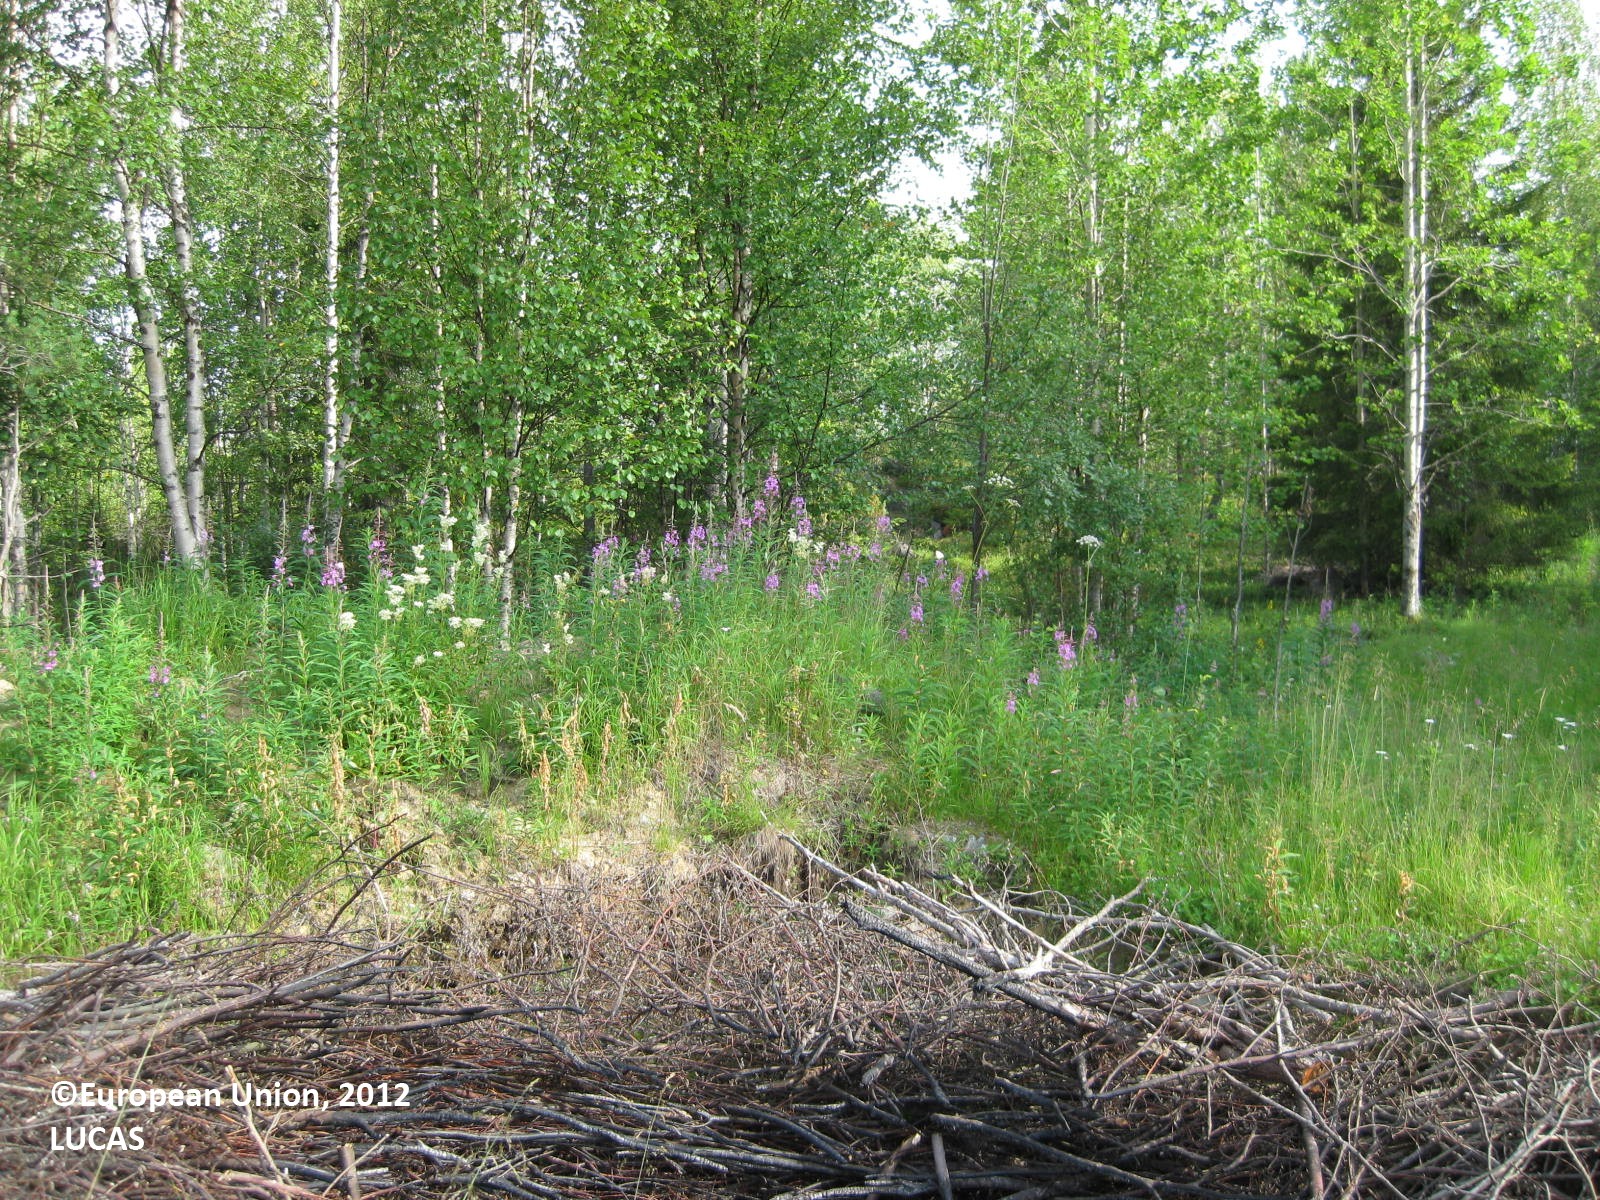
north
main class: Grassland
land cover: Grassland with sparse tree/shrub cover
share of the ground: > 75 %
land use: Residential
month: July
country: FI
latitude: 65.8389
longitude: 28.4821
